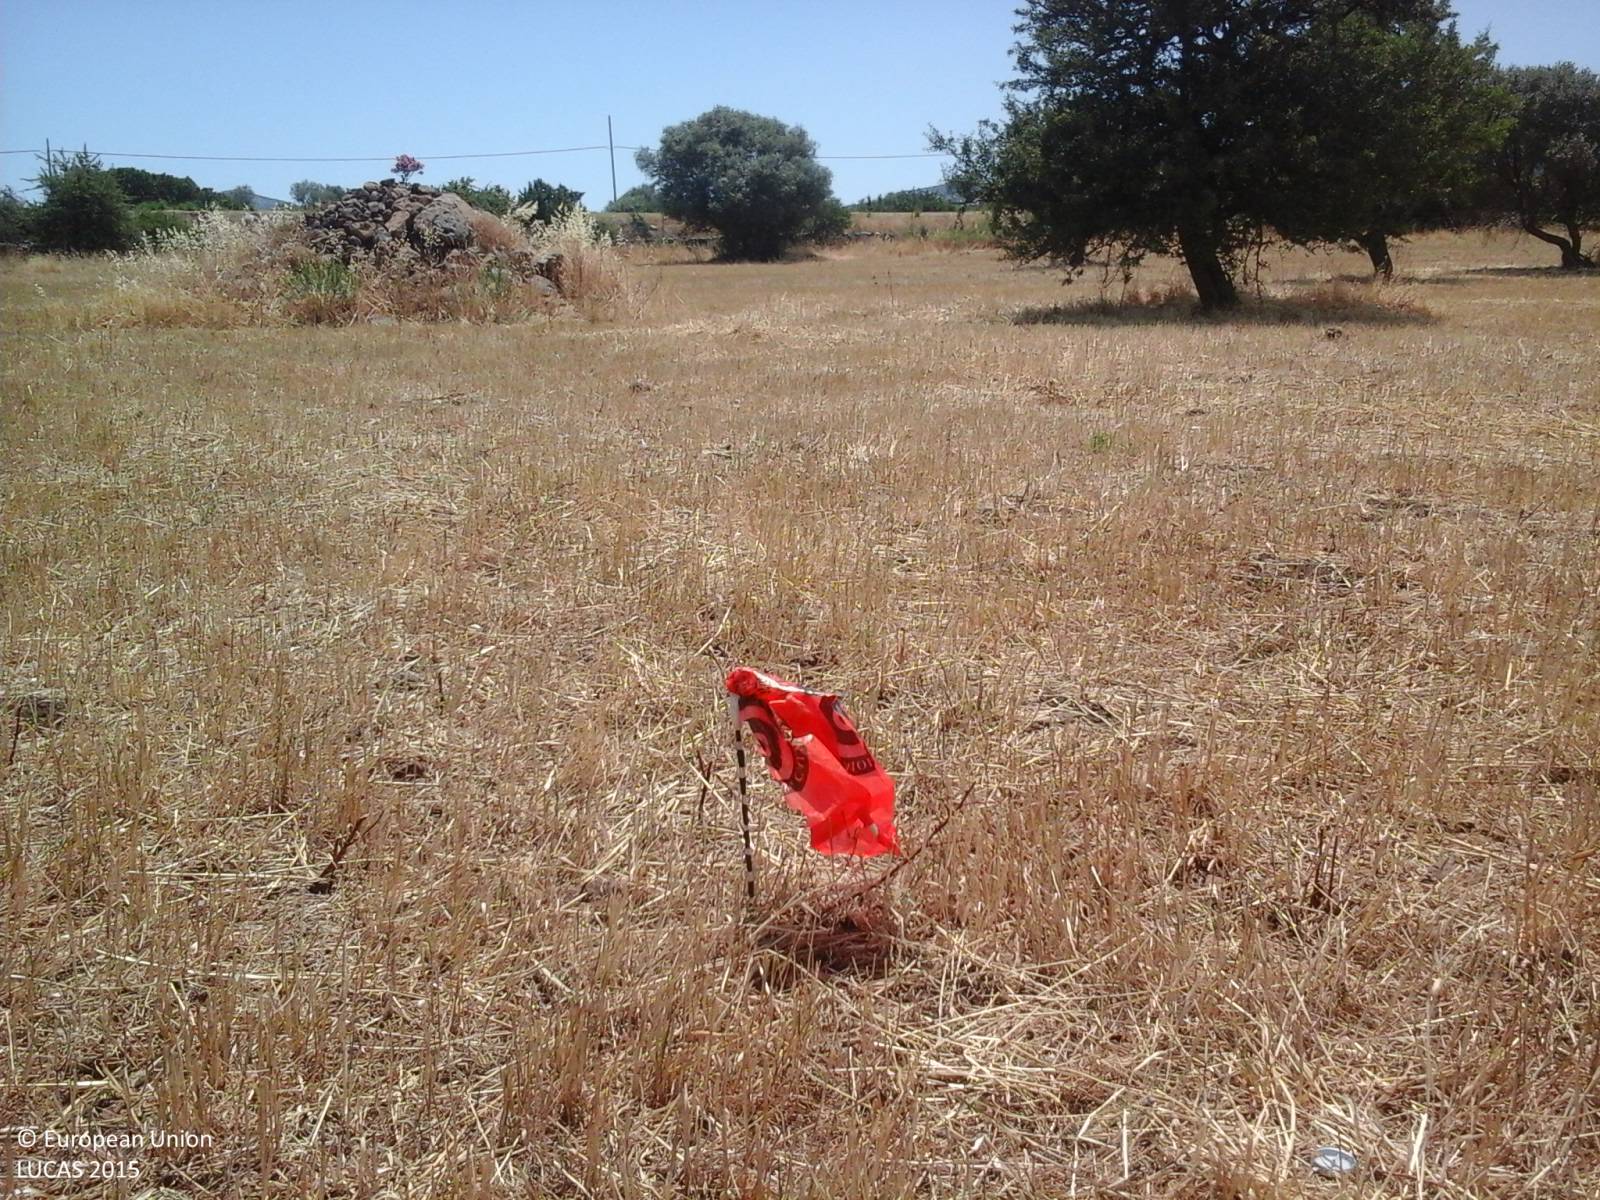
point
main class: Grassland
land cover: Grassland without tree/shrub cover
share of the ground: > 75 %
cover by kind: herbaceous plants 95 %, unconsolidated bare surface 5 %
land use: Agriculture (excluding fallow land and kitchen gardens)
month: June
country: IT
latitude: 40.3389
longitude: 9.5901
